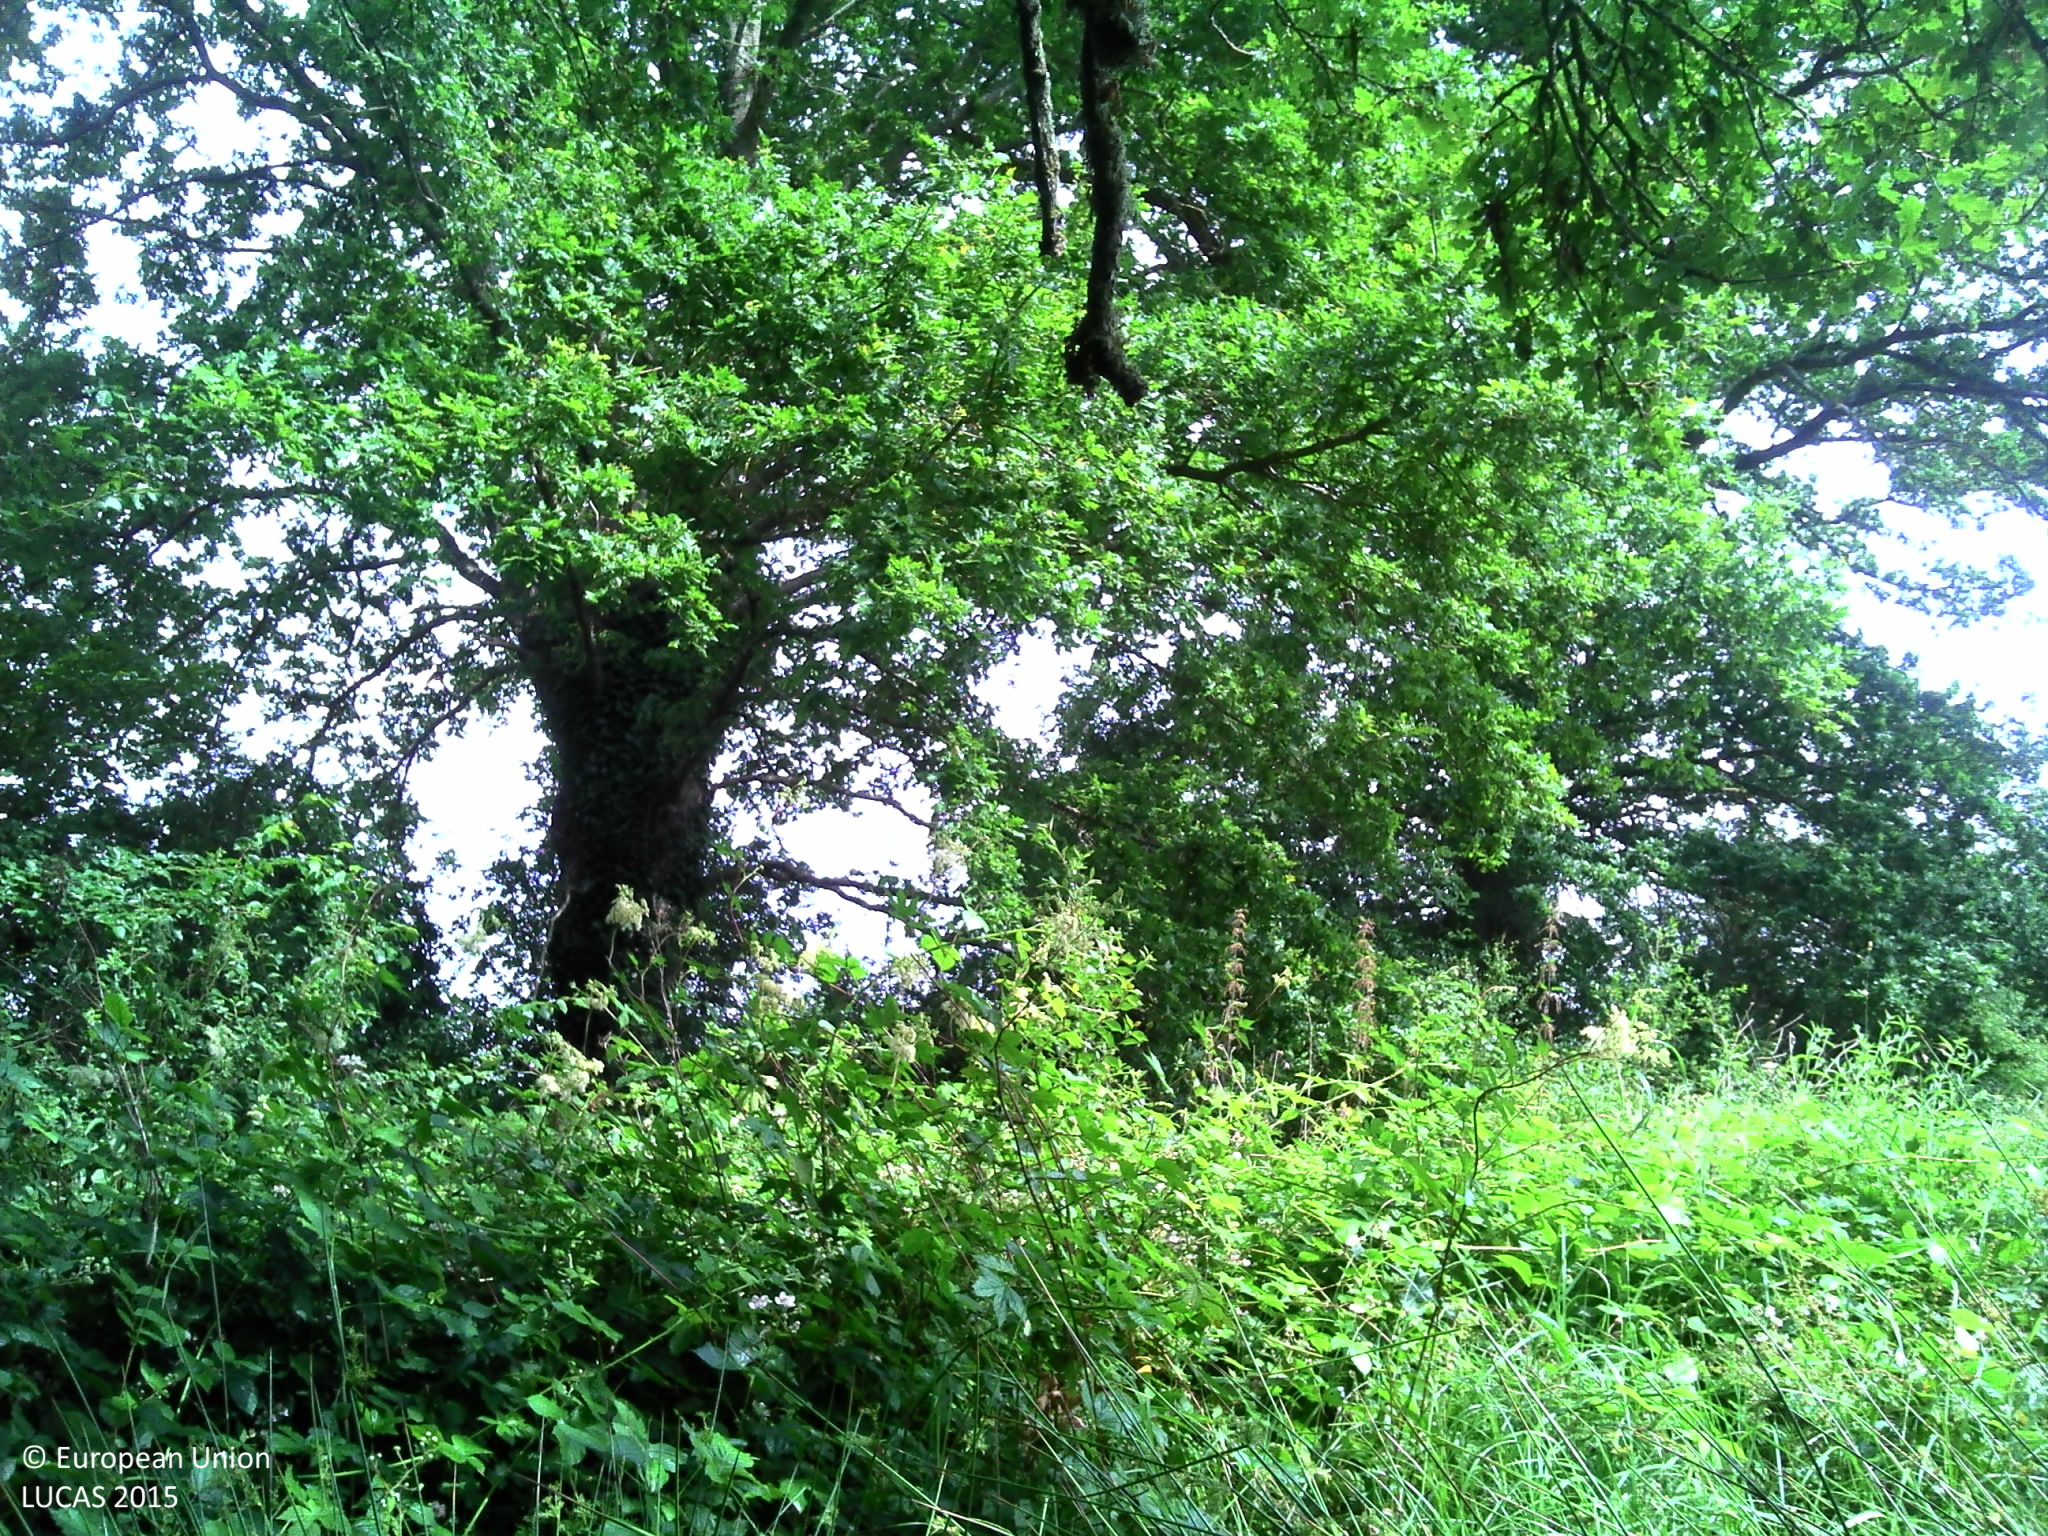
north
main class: Woodland
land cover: Broadleaved woodland
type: beech forest
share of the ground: > 75 %
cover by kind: broadleaved forest trees 75 %, herbaceous plants 15 %, shrubs 10 %
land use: Forestry
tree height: > 5 m
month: June
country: FR
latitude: 48.4383
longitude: 0.1995
